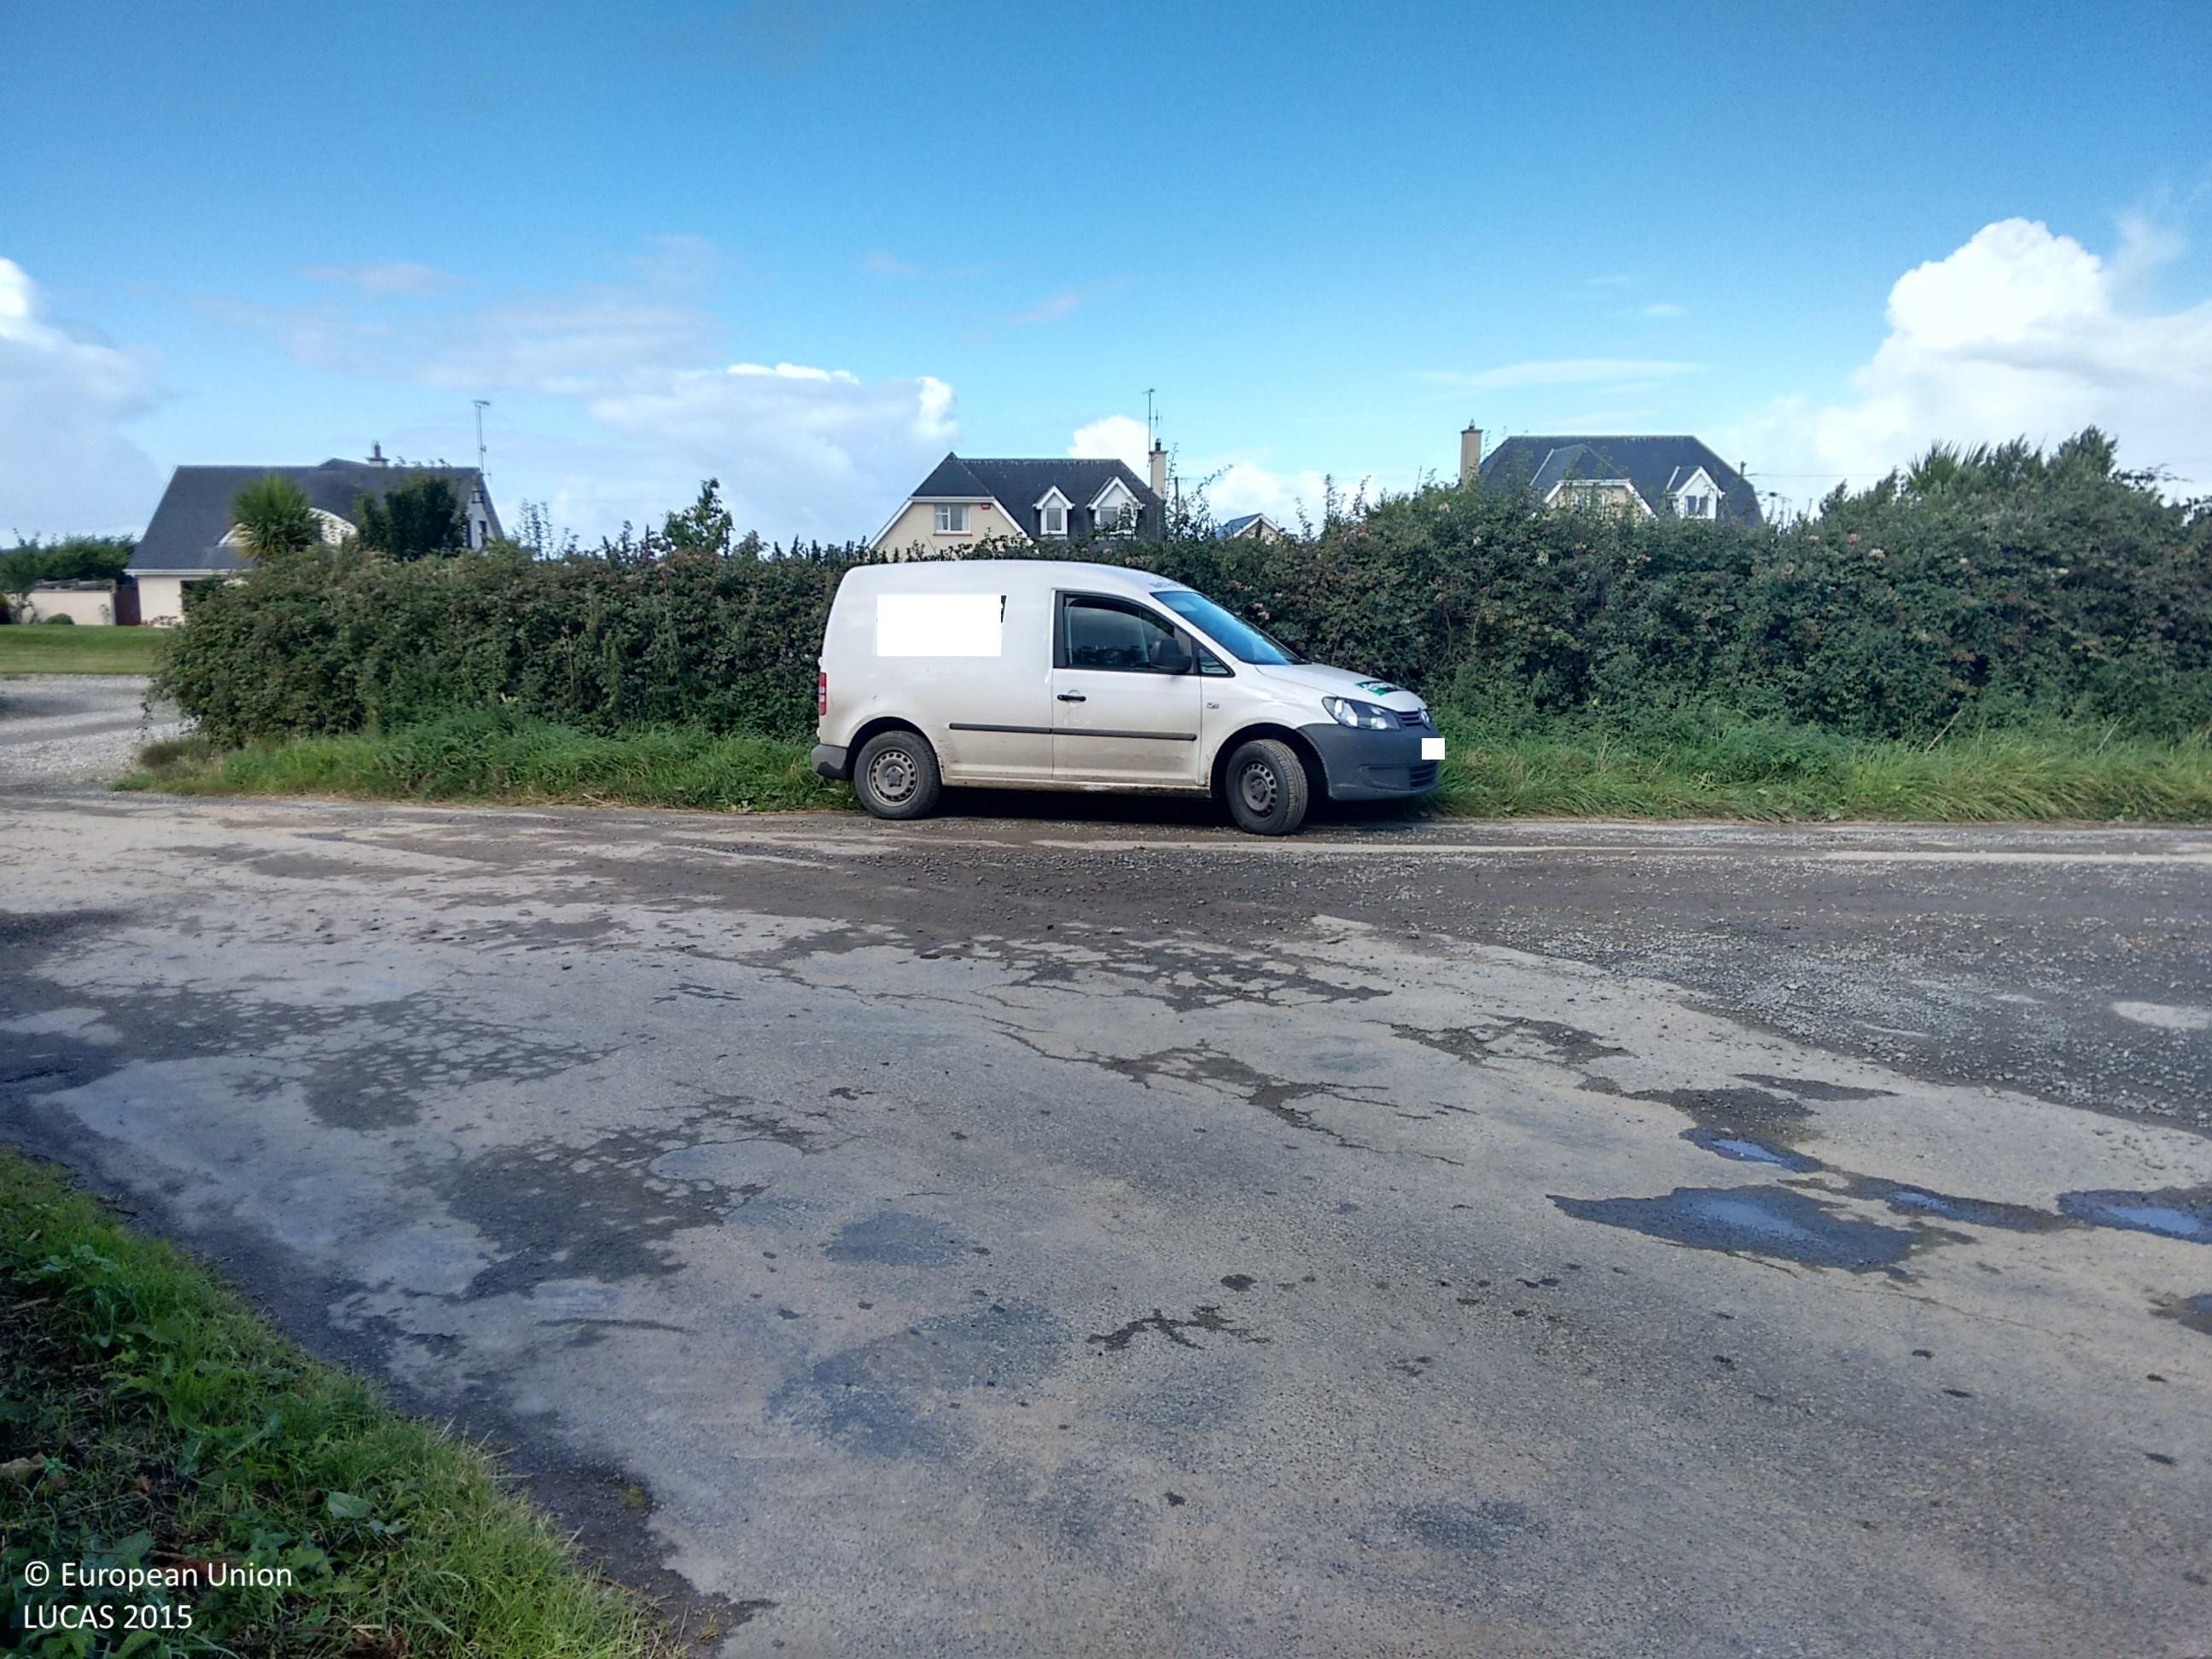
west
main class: Grassland
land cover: Grassland without tree/shrub cover
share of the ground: > 75 %
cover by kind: herbaceous plants 100 %
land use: Agriculture (excluding fallow land and kitchen gardens)
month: August
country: IE
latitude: 52.1991
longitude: -6.5301
